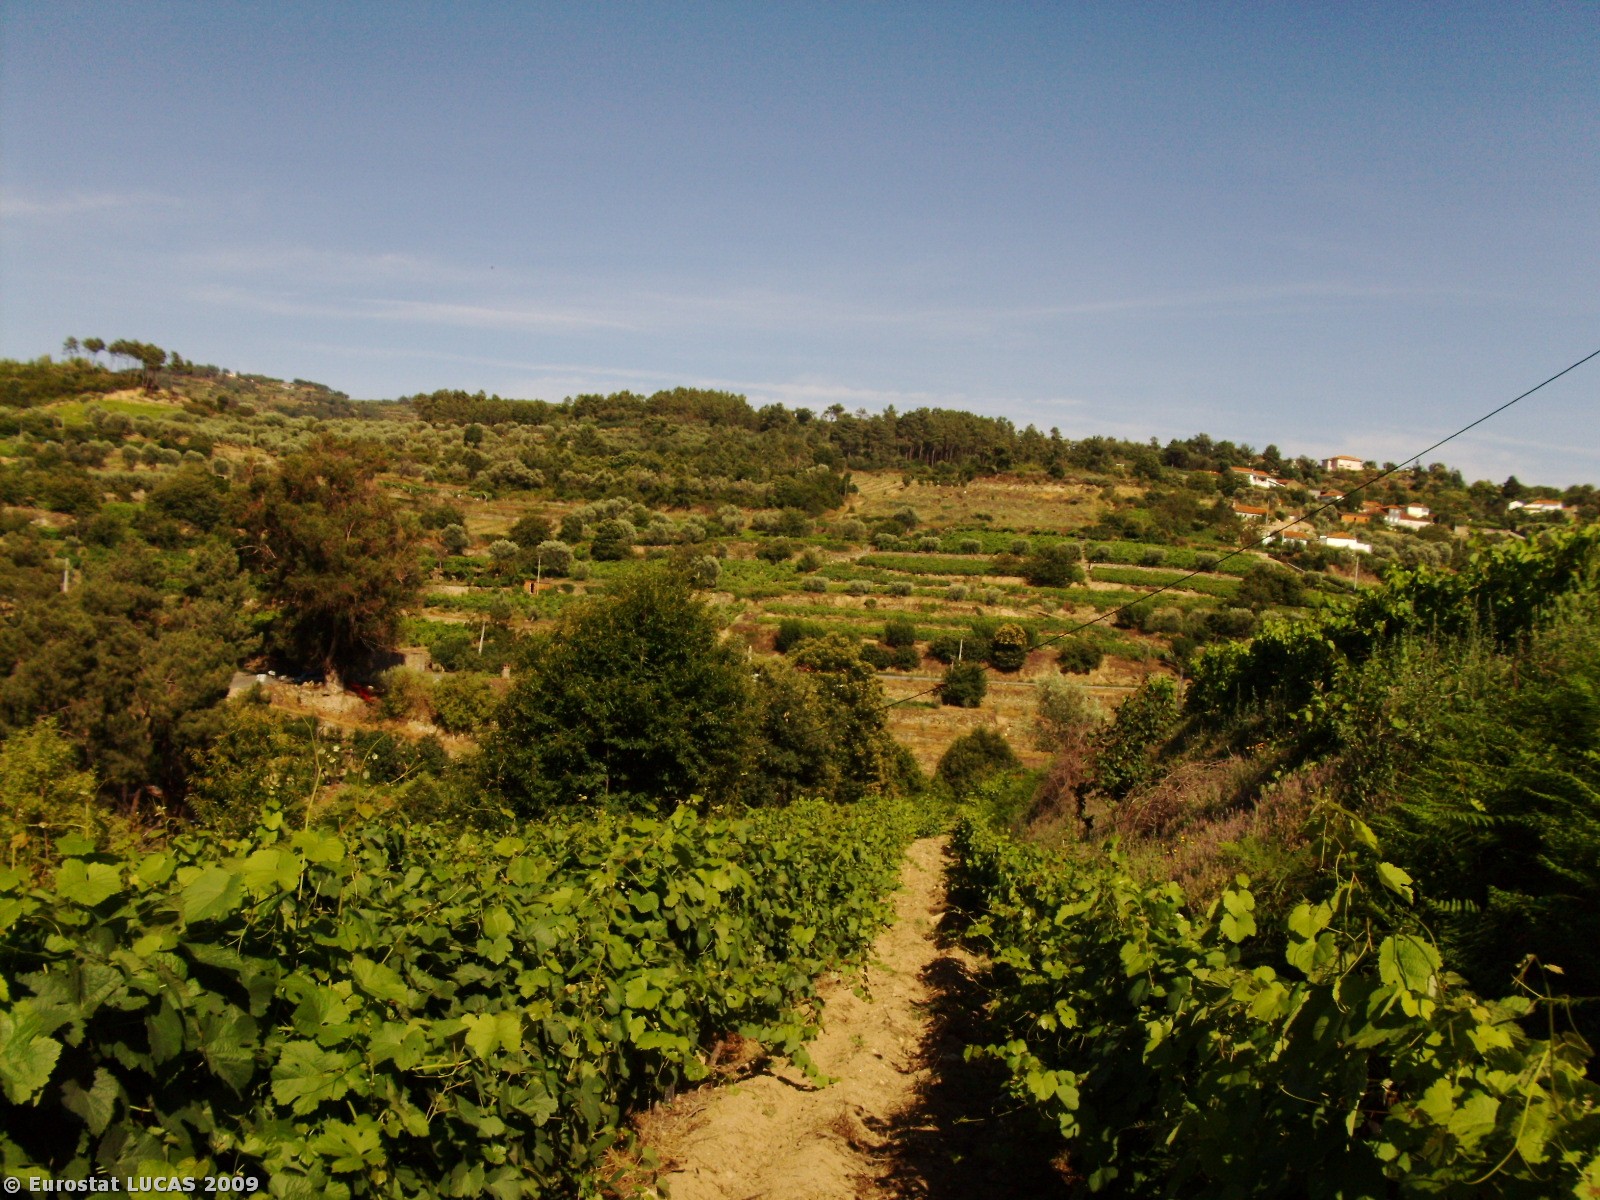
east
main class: Cropland
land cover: Vineyards
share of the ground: 25 - 50 %
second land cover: Bare land
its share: > 75 %
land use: Agriculture (excluding fallow land and kitchen gardens)
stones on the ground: < 10 %
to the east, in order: Vineyards; Broadleaved woodland; Inland running water; Broadleaved woodland; Dry pulses; Electric lines; Dry pulses; Dry stone walls; Pear fruit; Dry stone walls; Electric lines; Spontaneously vegetated surfaces; Pear fruit; Dry stone walls; Tracks; Single bushes/trees; Paved roads, cycling and walking lanes; Electric lines; Dry stone walls; Vineyards; Dry stone walls; Vineyards
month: July
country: PT
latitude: 41.0842
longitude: -7.7811
